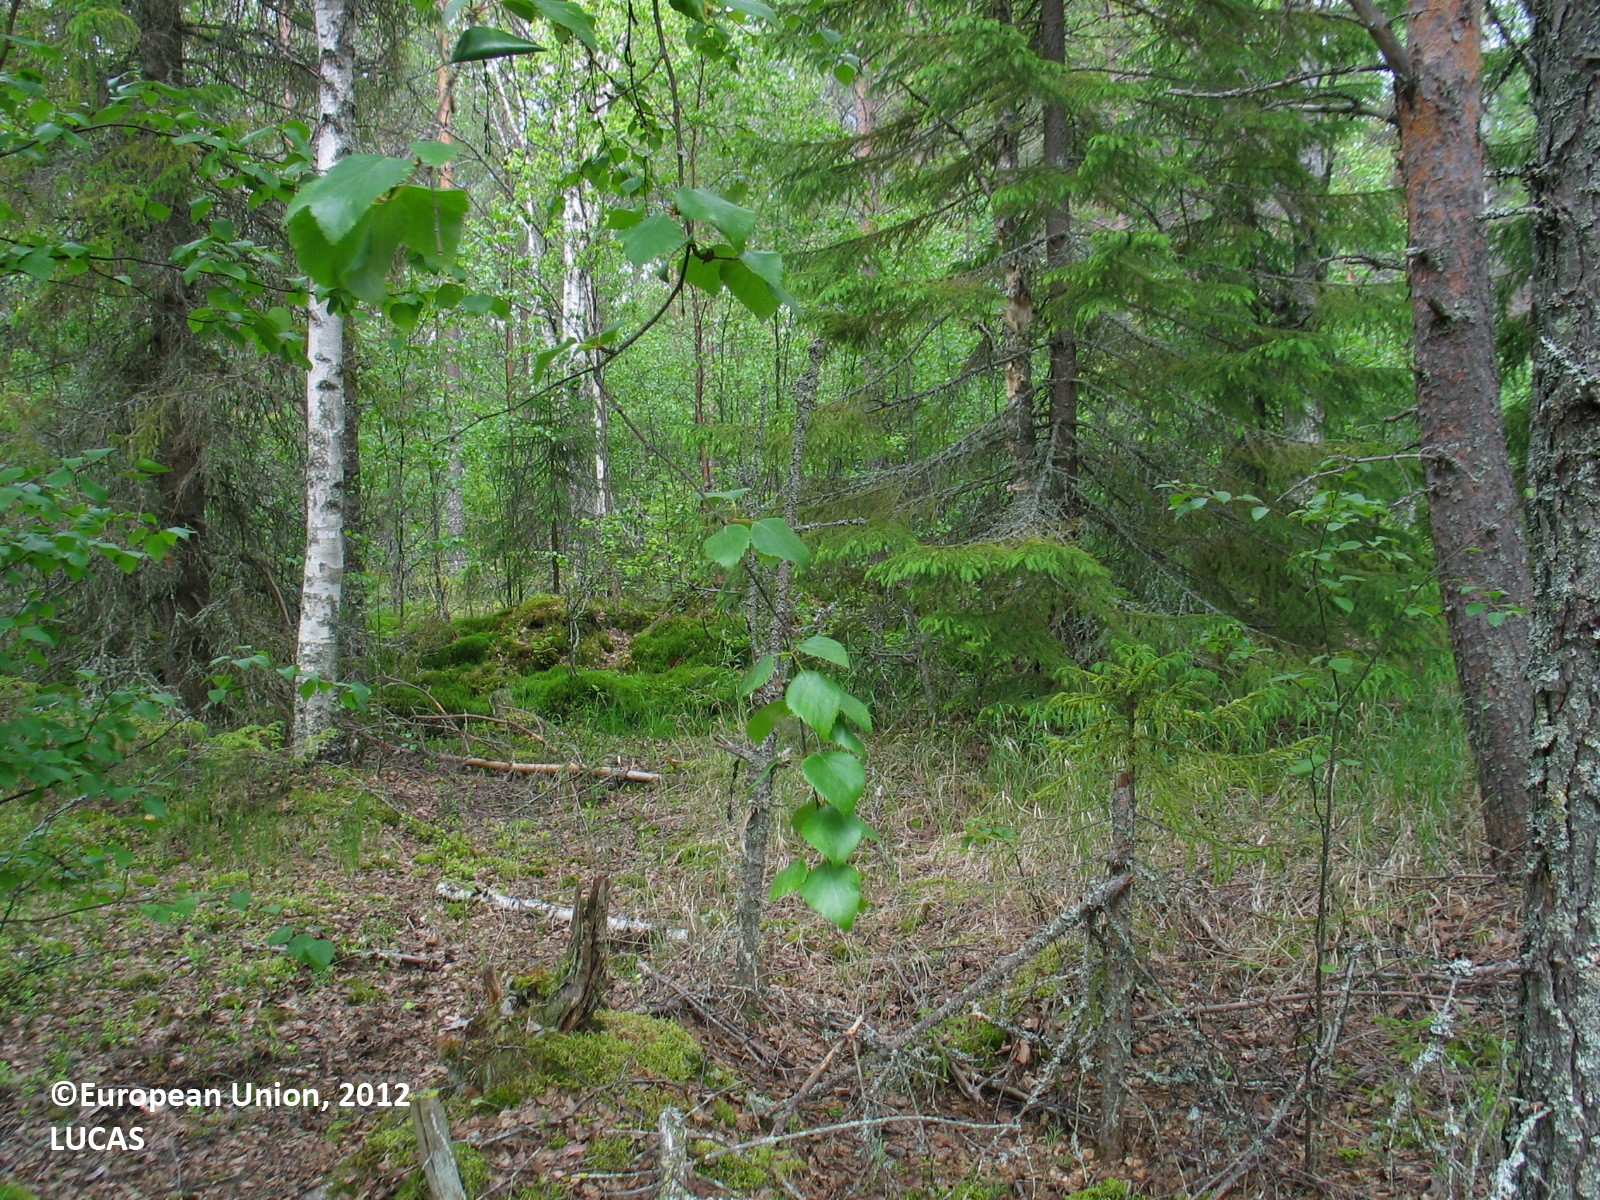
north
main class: Woodland
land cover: Other mixed woodland
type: boreal forest
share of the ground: 50 - 75 %
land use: Forestry
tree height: > 5 m
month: June
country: FI
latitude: 64.8257
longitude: 26.4809
